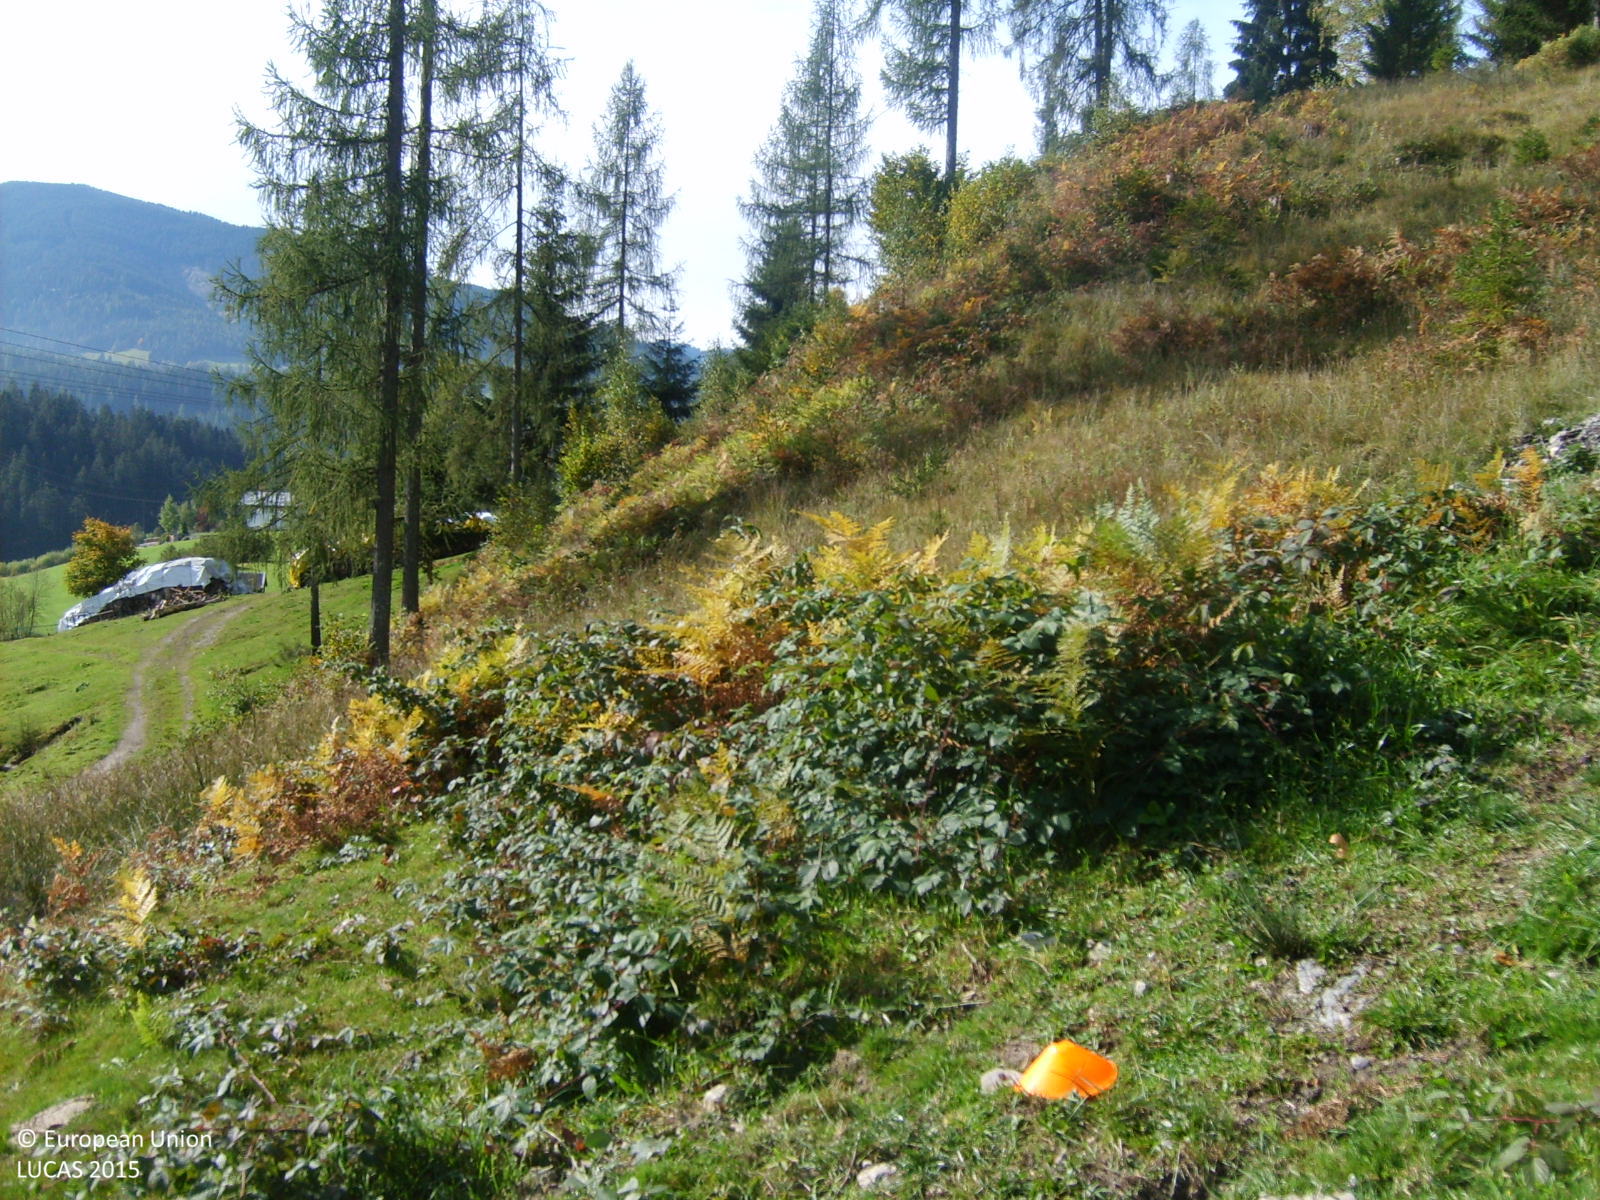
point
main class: Grassland
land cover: Grassland without tree/shrub cover
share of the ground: > 75 %
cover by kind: herbaceous plants 95 %, shrubs 5 %
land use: Agriculture (excluding fallow land and kitchen gardens)
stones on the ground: 10 - 25 %
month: September
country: AT
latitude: 47.4340
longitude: 13.3527
